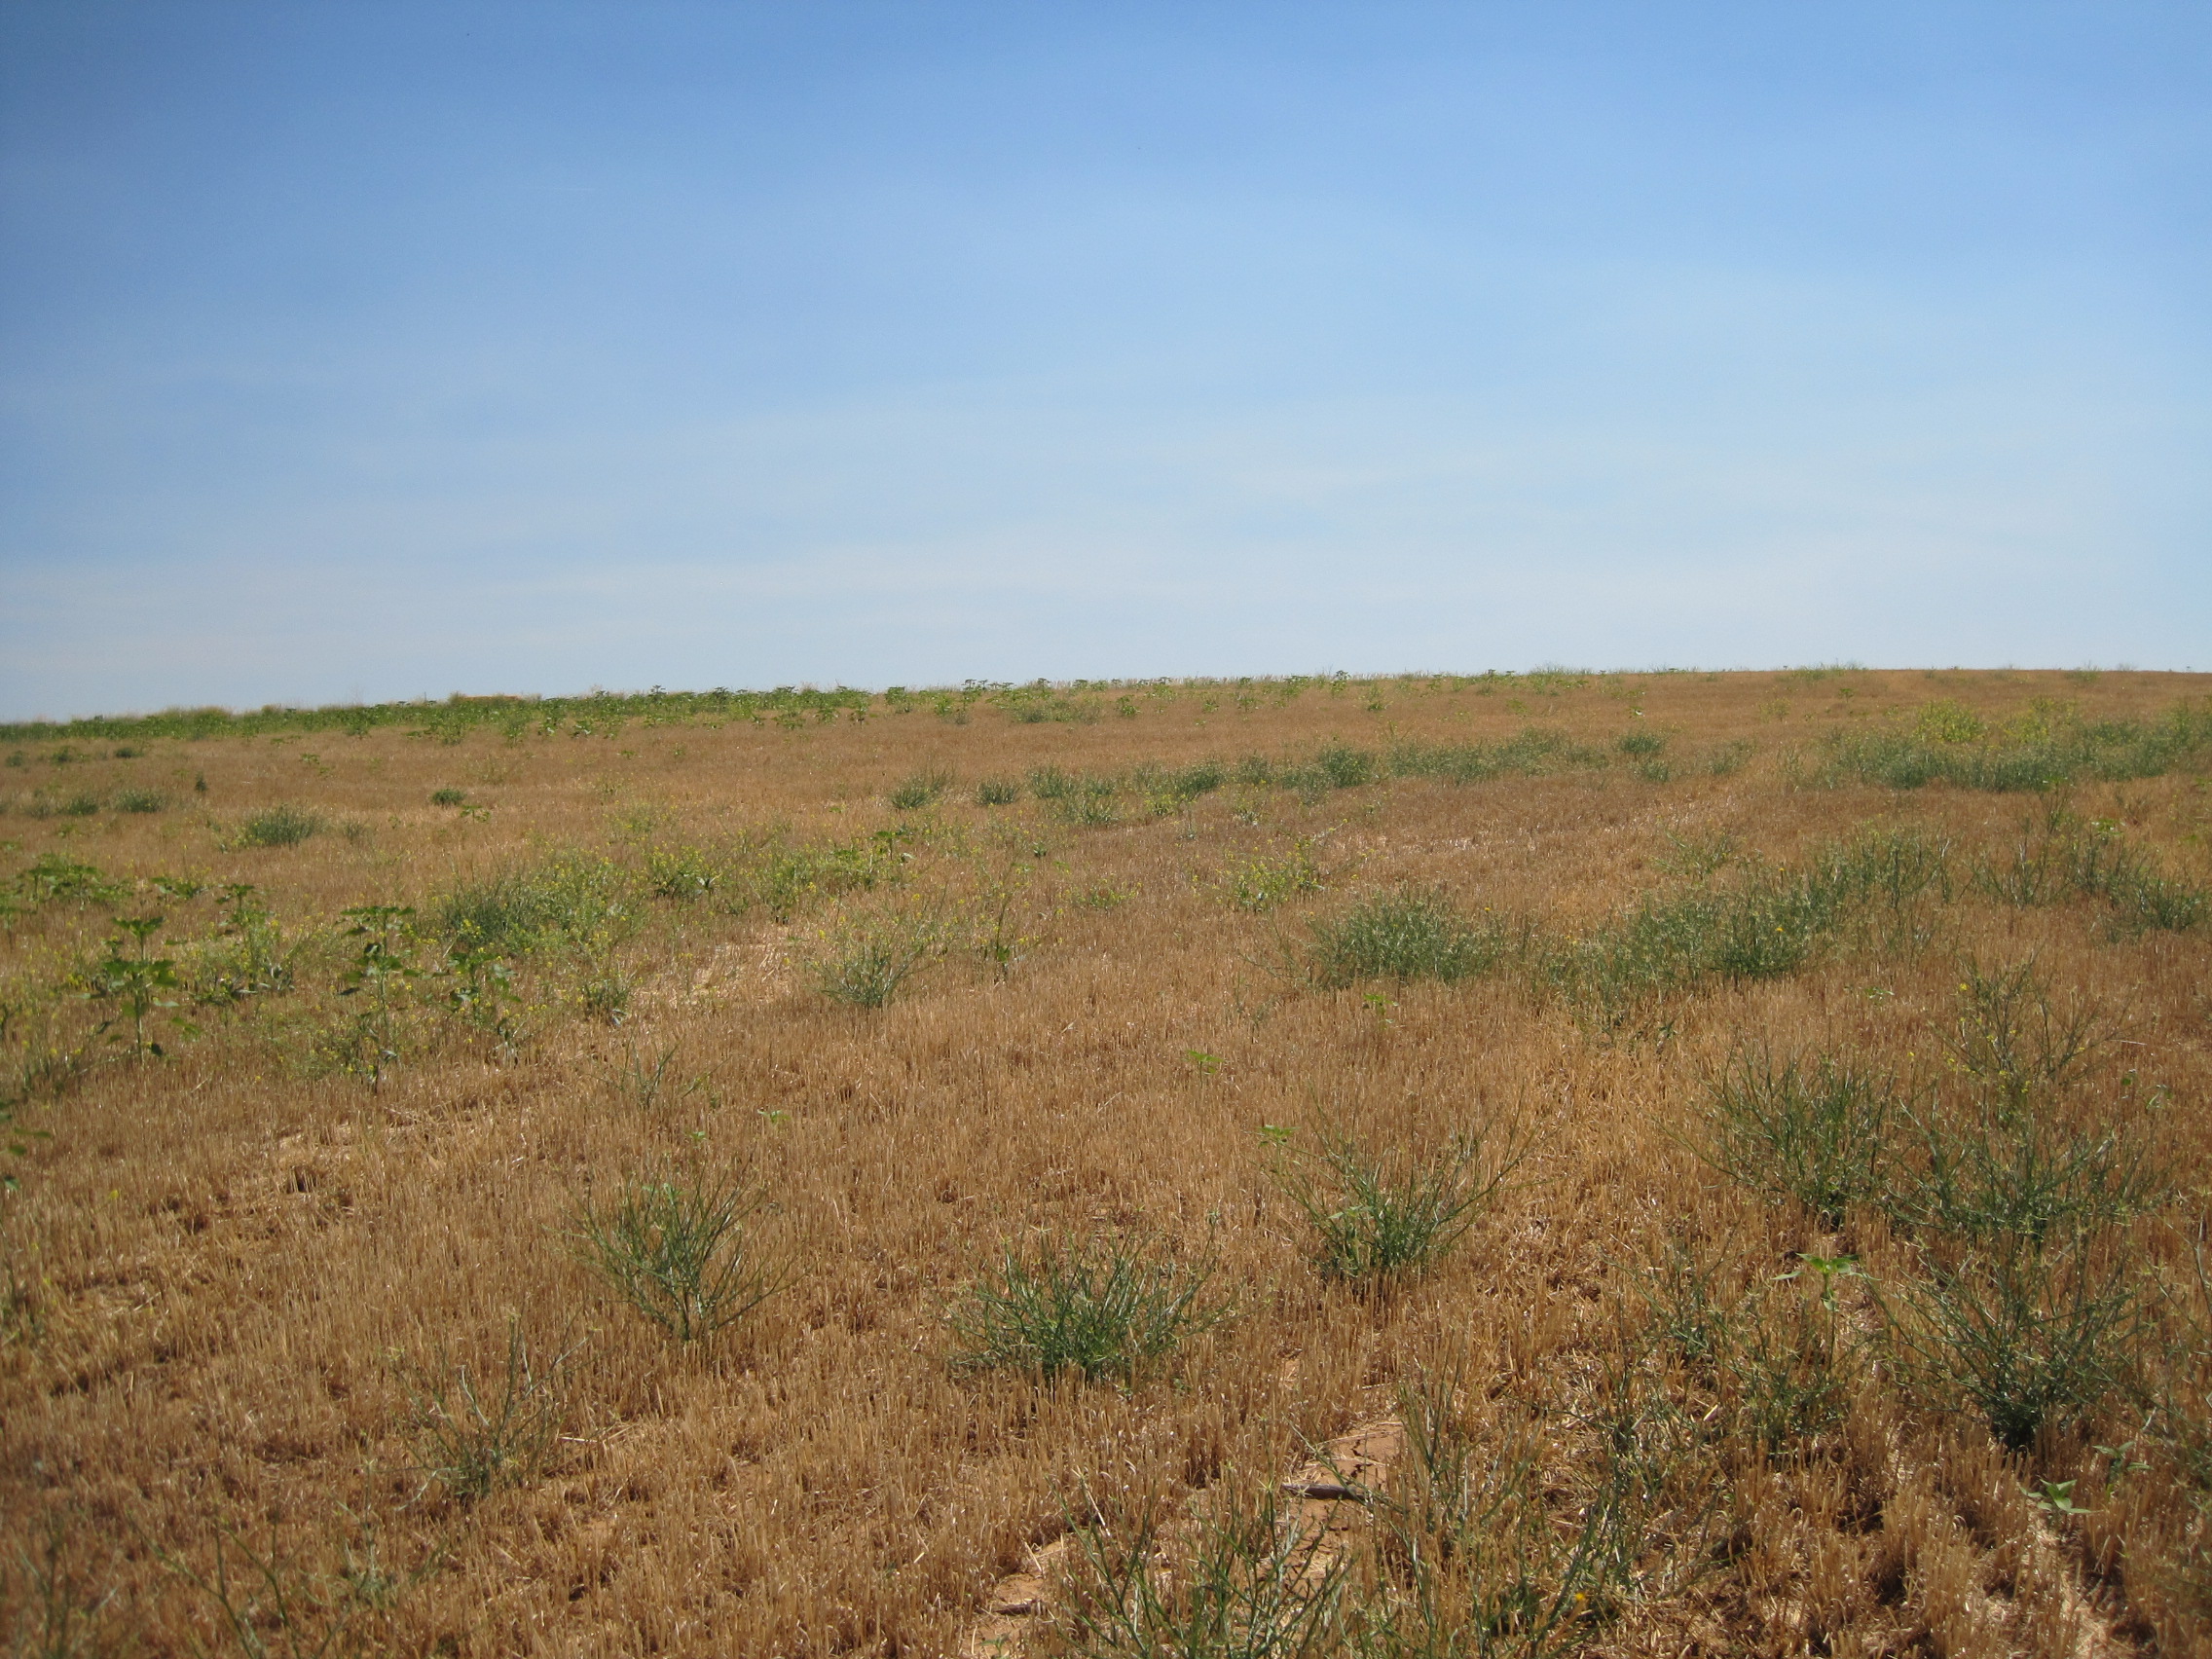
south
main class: Cropland
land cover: Barley
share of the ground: < 10 %
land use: Agriculture (excluding fallow land and kitchen gardens)
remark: Harvested field
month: July
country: ES
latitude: 42.1235
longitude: -5.3152
